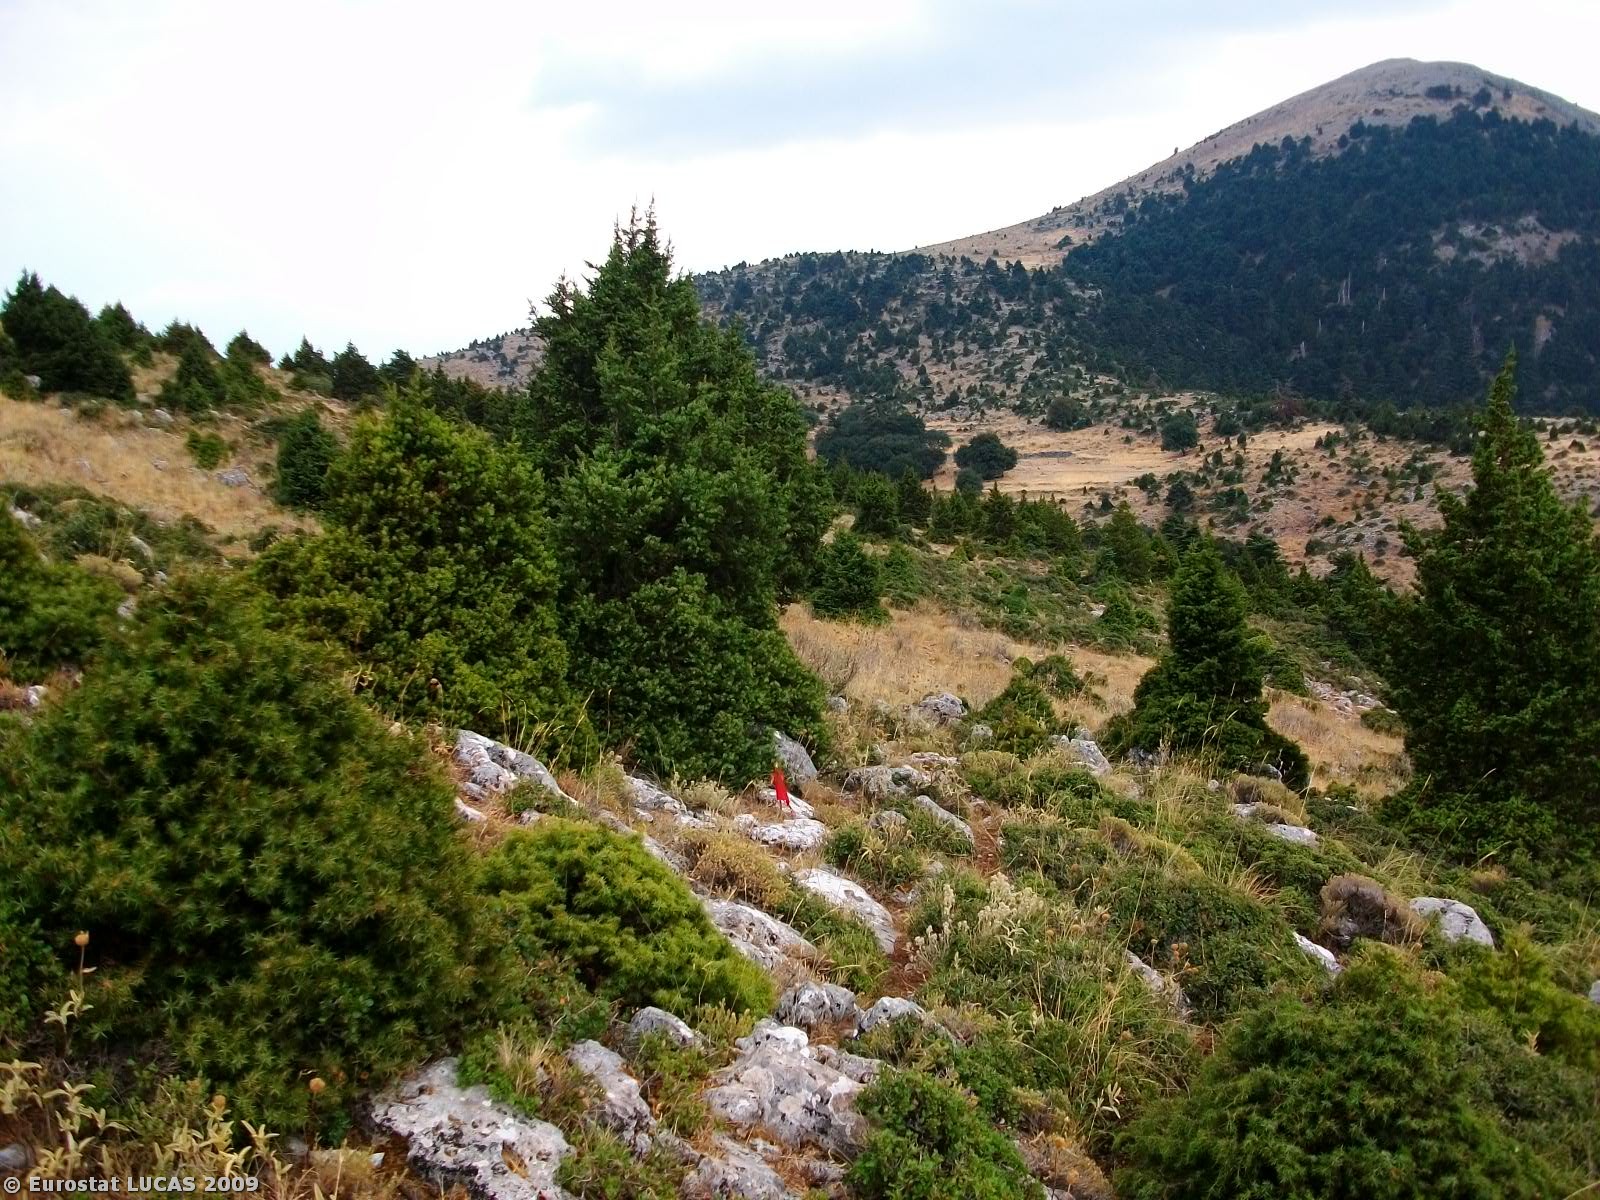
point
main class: Woodland
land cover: Coniferous woodland
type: coniferous forest of the mediterranean region
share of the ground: 10 - 25 %
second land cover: Shrubland with sparse tree cover
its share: 25 - 50 %
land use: Forestry
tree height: > 5 m
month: August
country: GR
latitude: 37.0306
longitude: 22.7616
